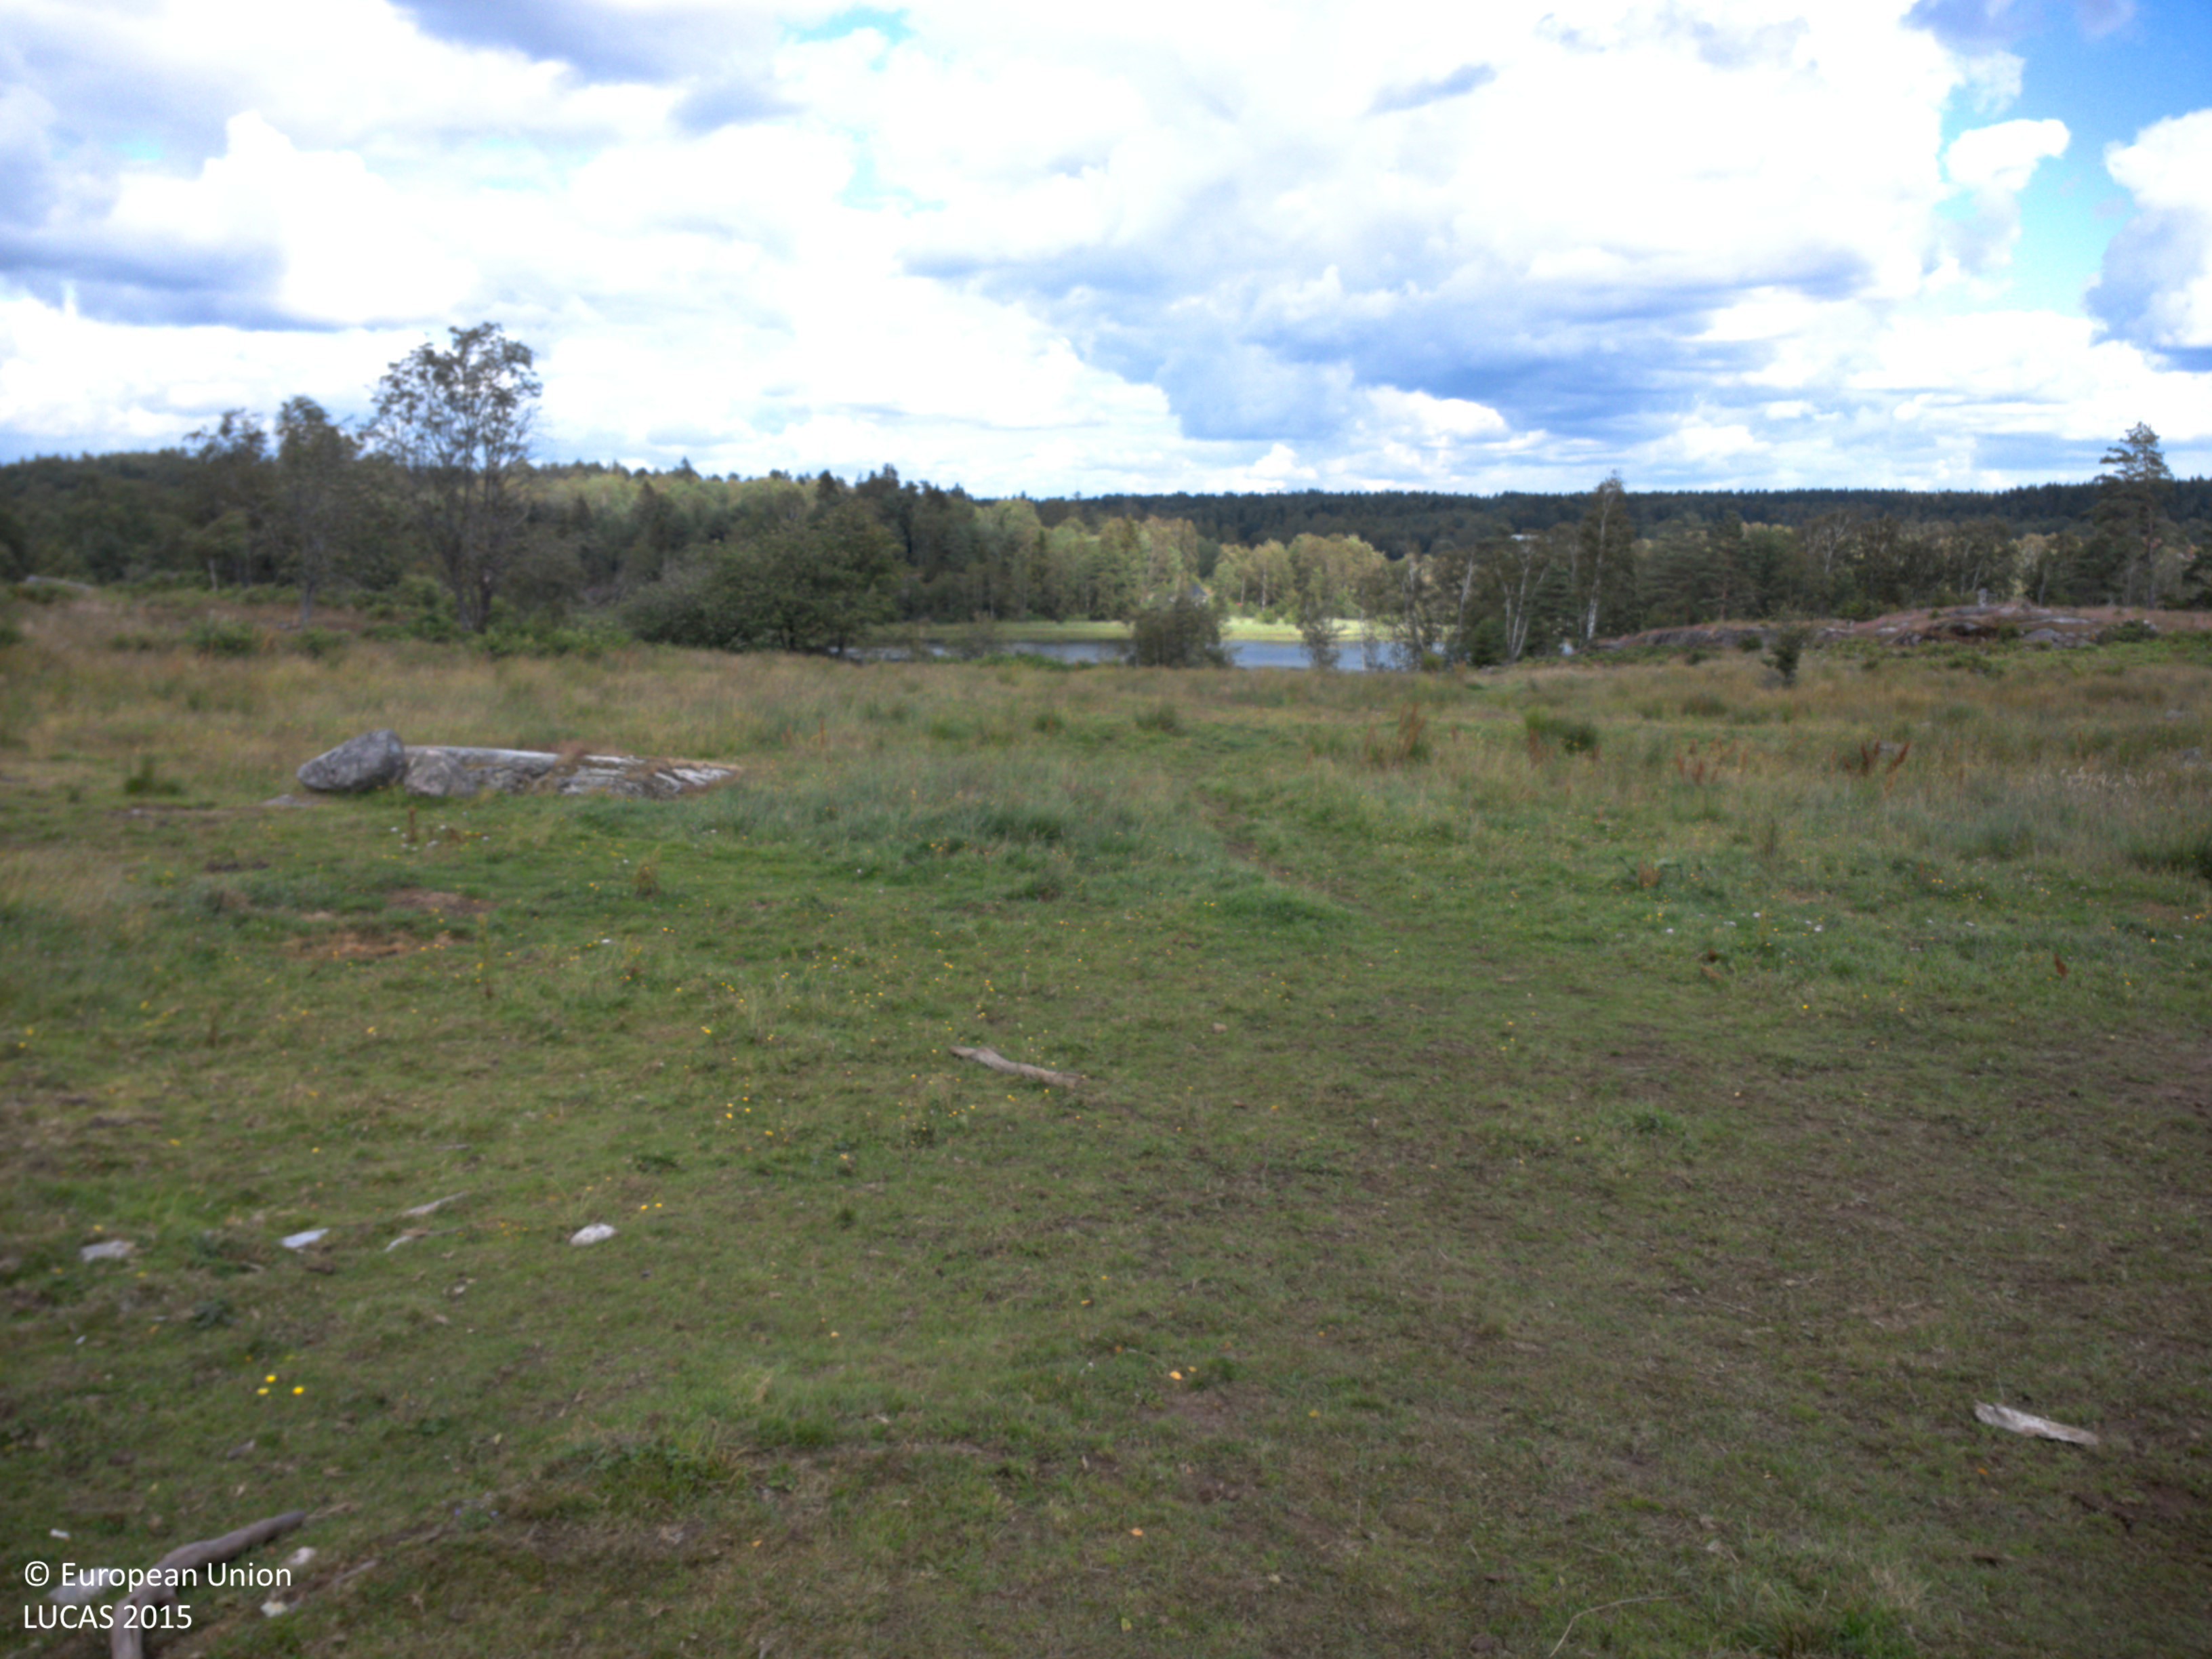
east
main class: Grassland
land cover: Grassland with sparse tree/shrub cover
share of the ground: > 75 %
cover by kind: herbaceous plants 75 %, consolidated bare surface 20 %, broadleaved forest trees 5 %
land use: Agriculture (excluding fallow land and kitchen gardens)
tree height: > 5 m
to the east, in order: Grassland with sparse tree/shrub cover; Pine dominated coniferous woodland; Broadleaved woodland; Inland marshes; Inland fresh water bodies
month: July
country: SE
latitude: 58.1897
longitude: 11.7825
